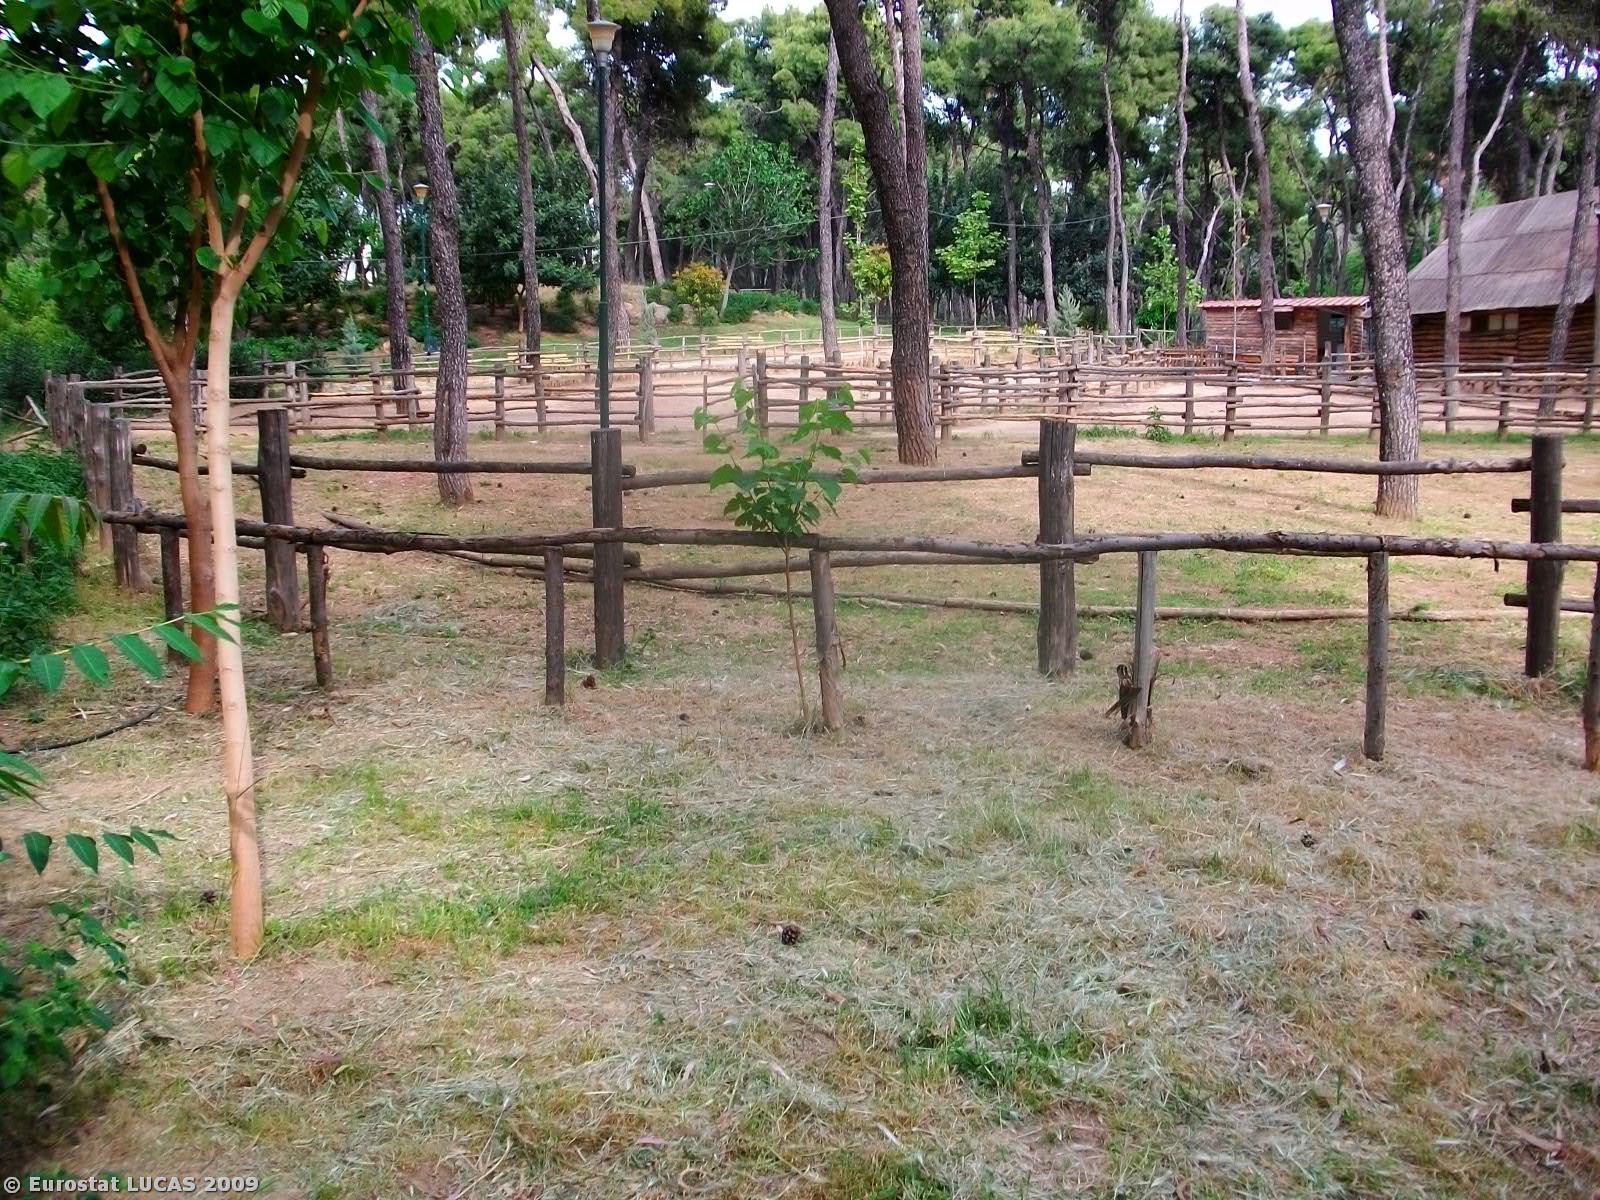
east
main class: Woodland
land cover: Coniferous woodland
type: coniferous forest of the mediterranean region
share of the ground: 50 - 75 %
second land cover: Spontaneously vegetated surfaces
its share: 50 - 75 %
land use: Amenities, museums, leisure
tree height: > 5 m
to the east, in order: Coniferous woodland; Spontaneously vegetated surfaces; Coniferous woodland; Fences; Artificial constructions in urban areas
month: May
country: GR
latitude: 37.9892
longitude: 23.7698
